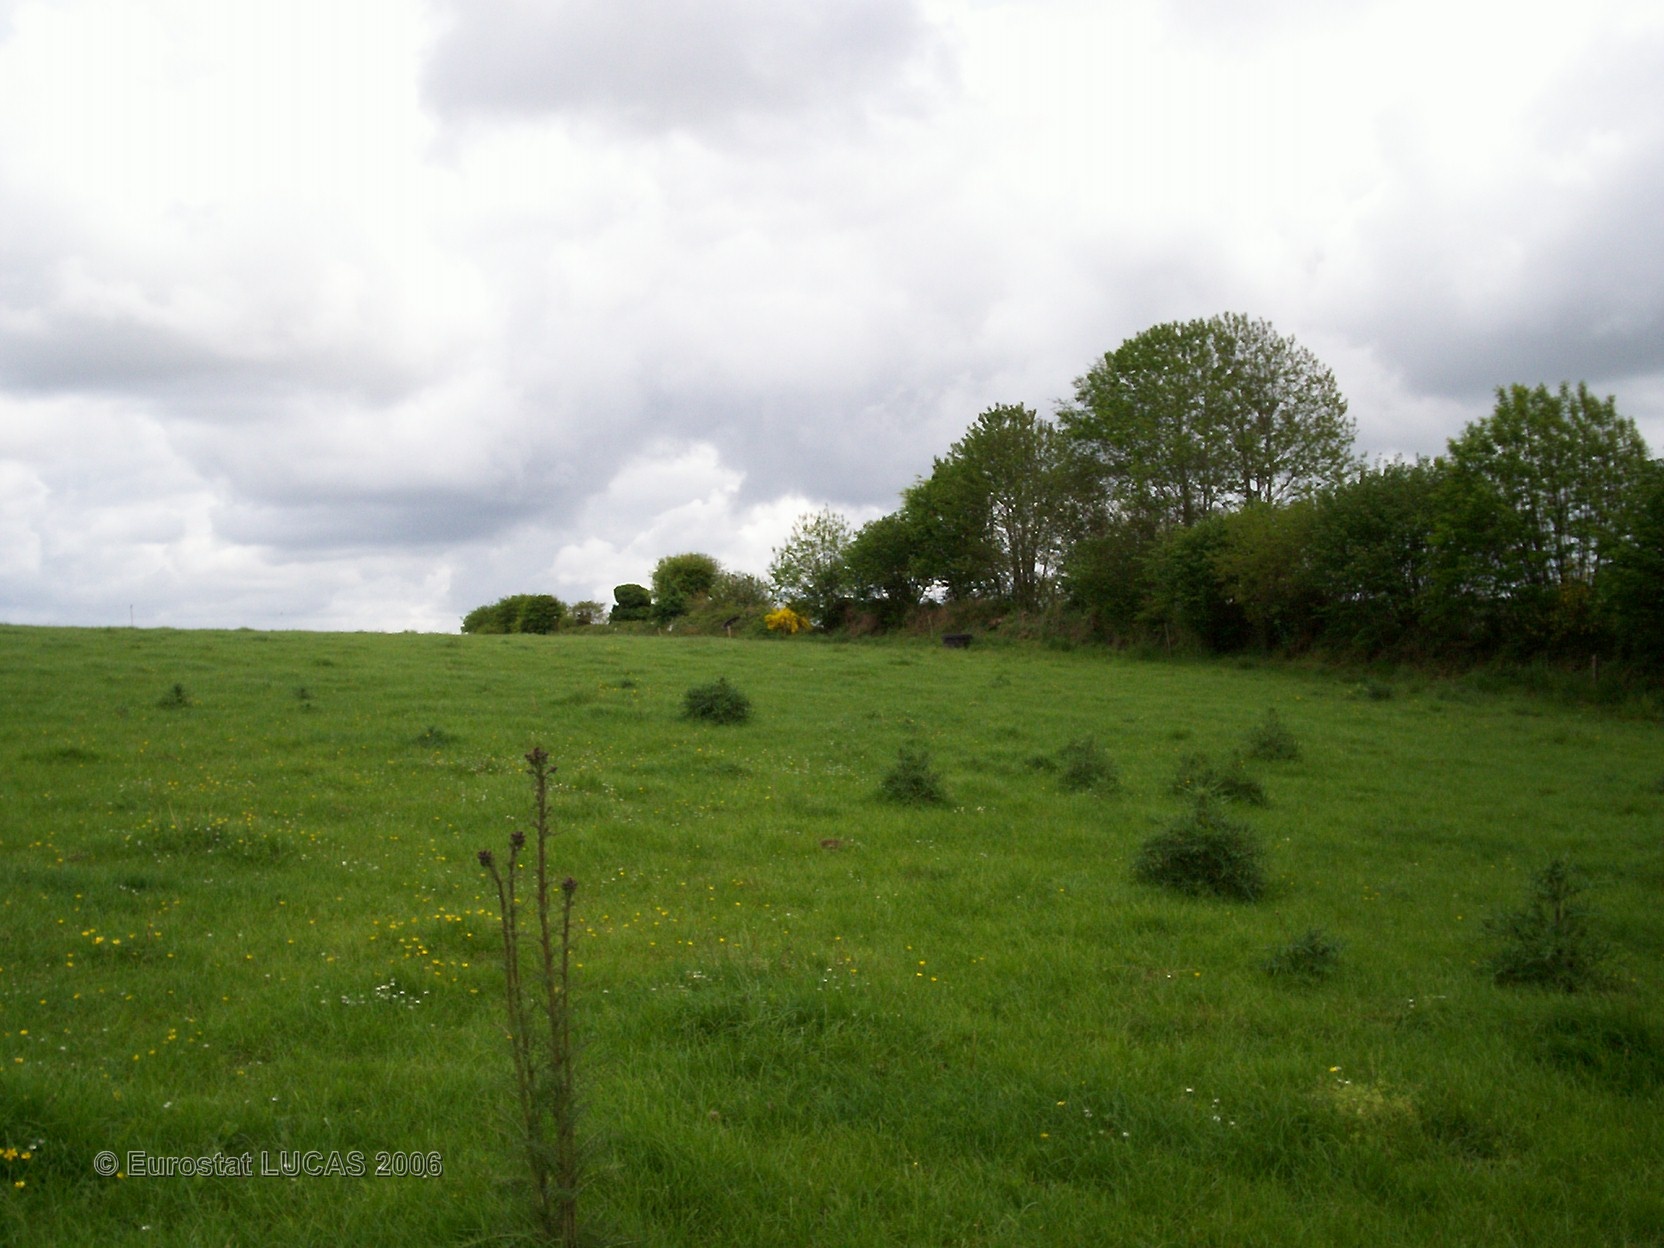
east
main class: Grassland
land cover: Grassland without tree/shrub cover
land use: Agriculture (excluding fallow land and kitchen gardens)
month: May
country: FR
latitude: 48.1039
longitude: -3.9038
